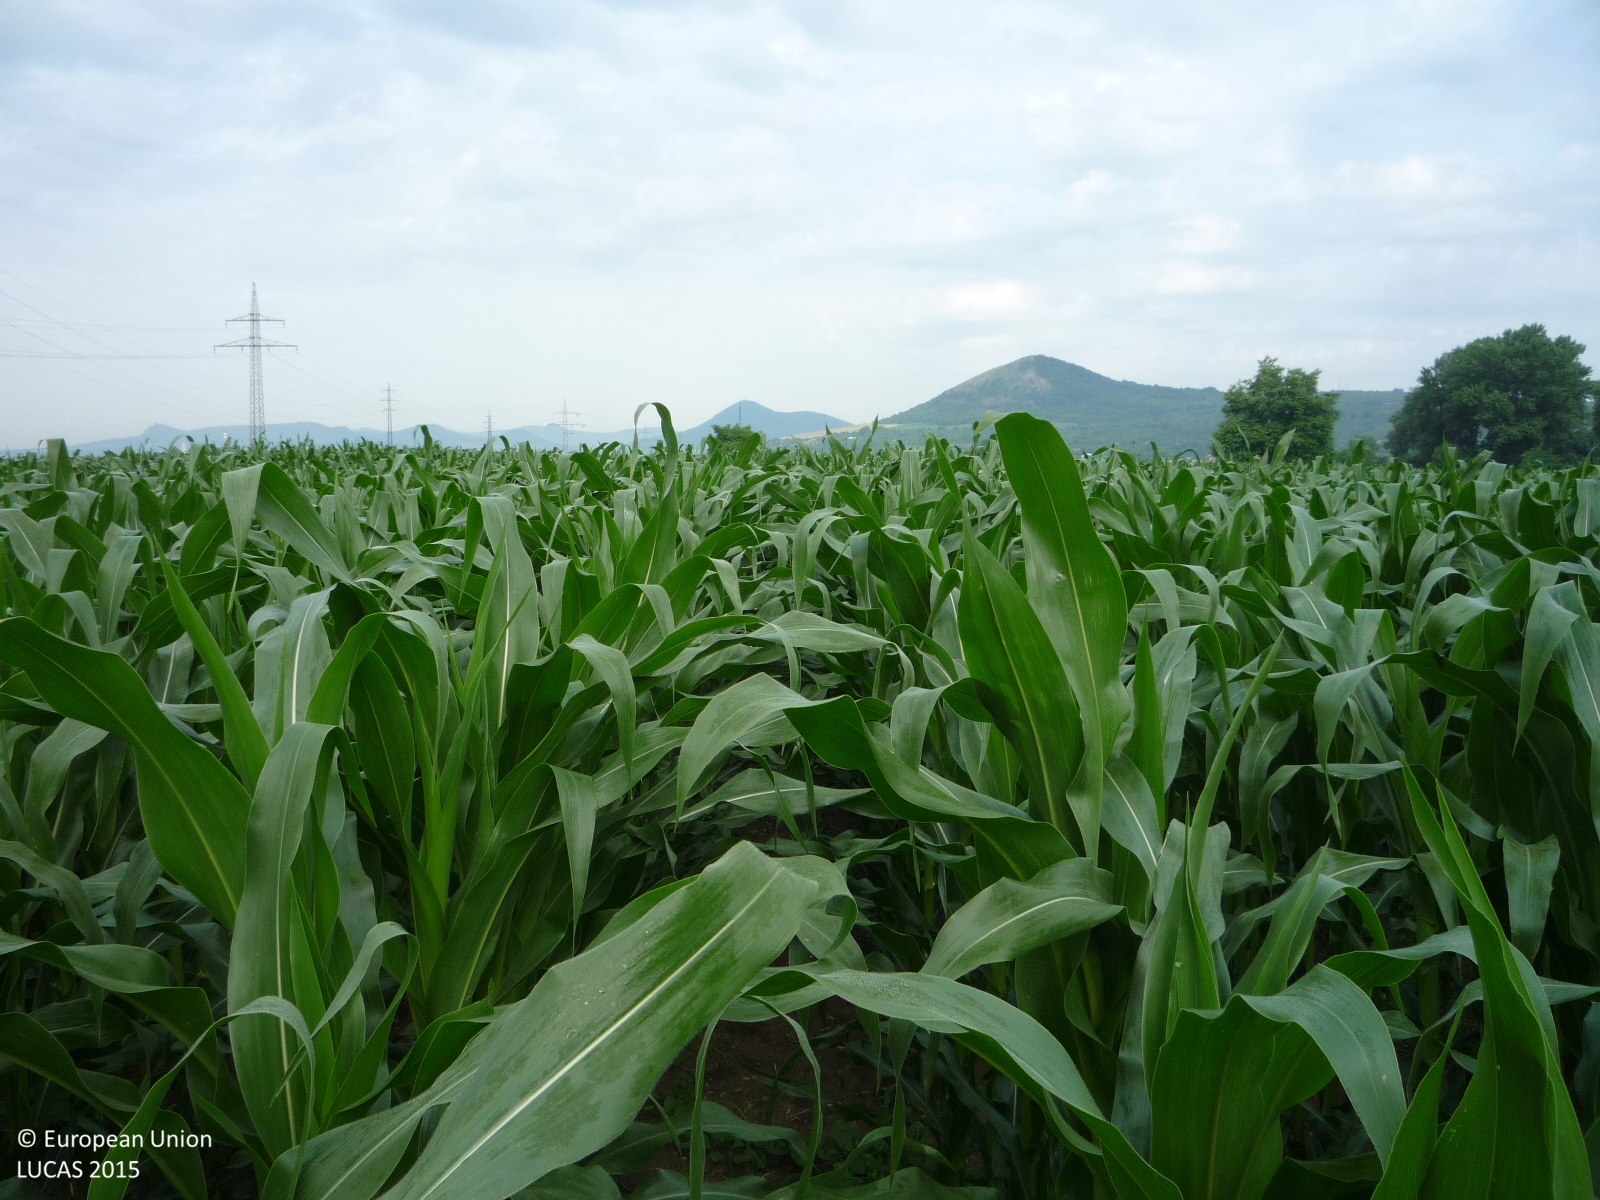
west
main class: Cropland
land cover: Maize
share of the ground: > 75 %
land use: Agriculture (excluding fallow land and kitchen gardens)
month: June
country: CZ
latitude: 50.5234
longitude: 14.1341
